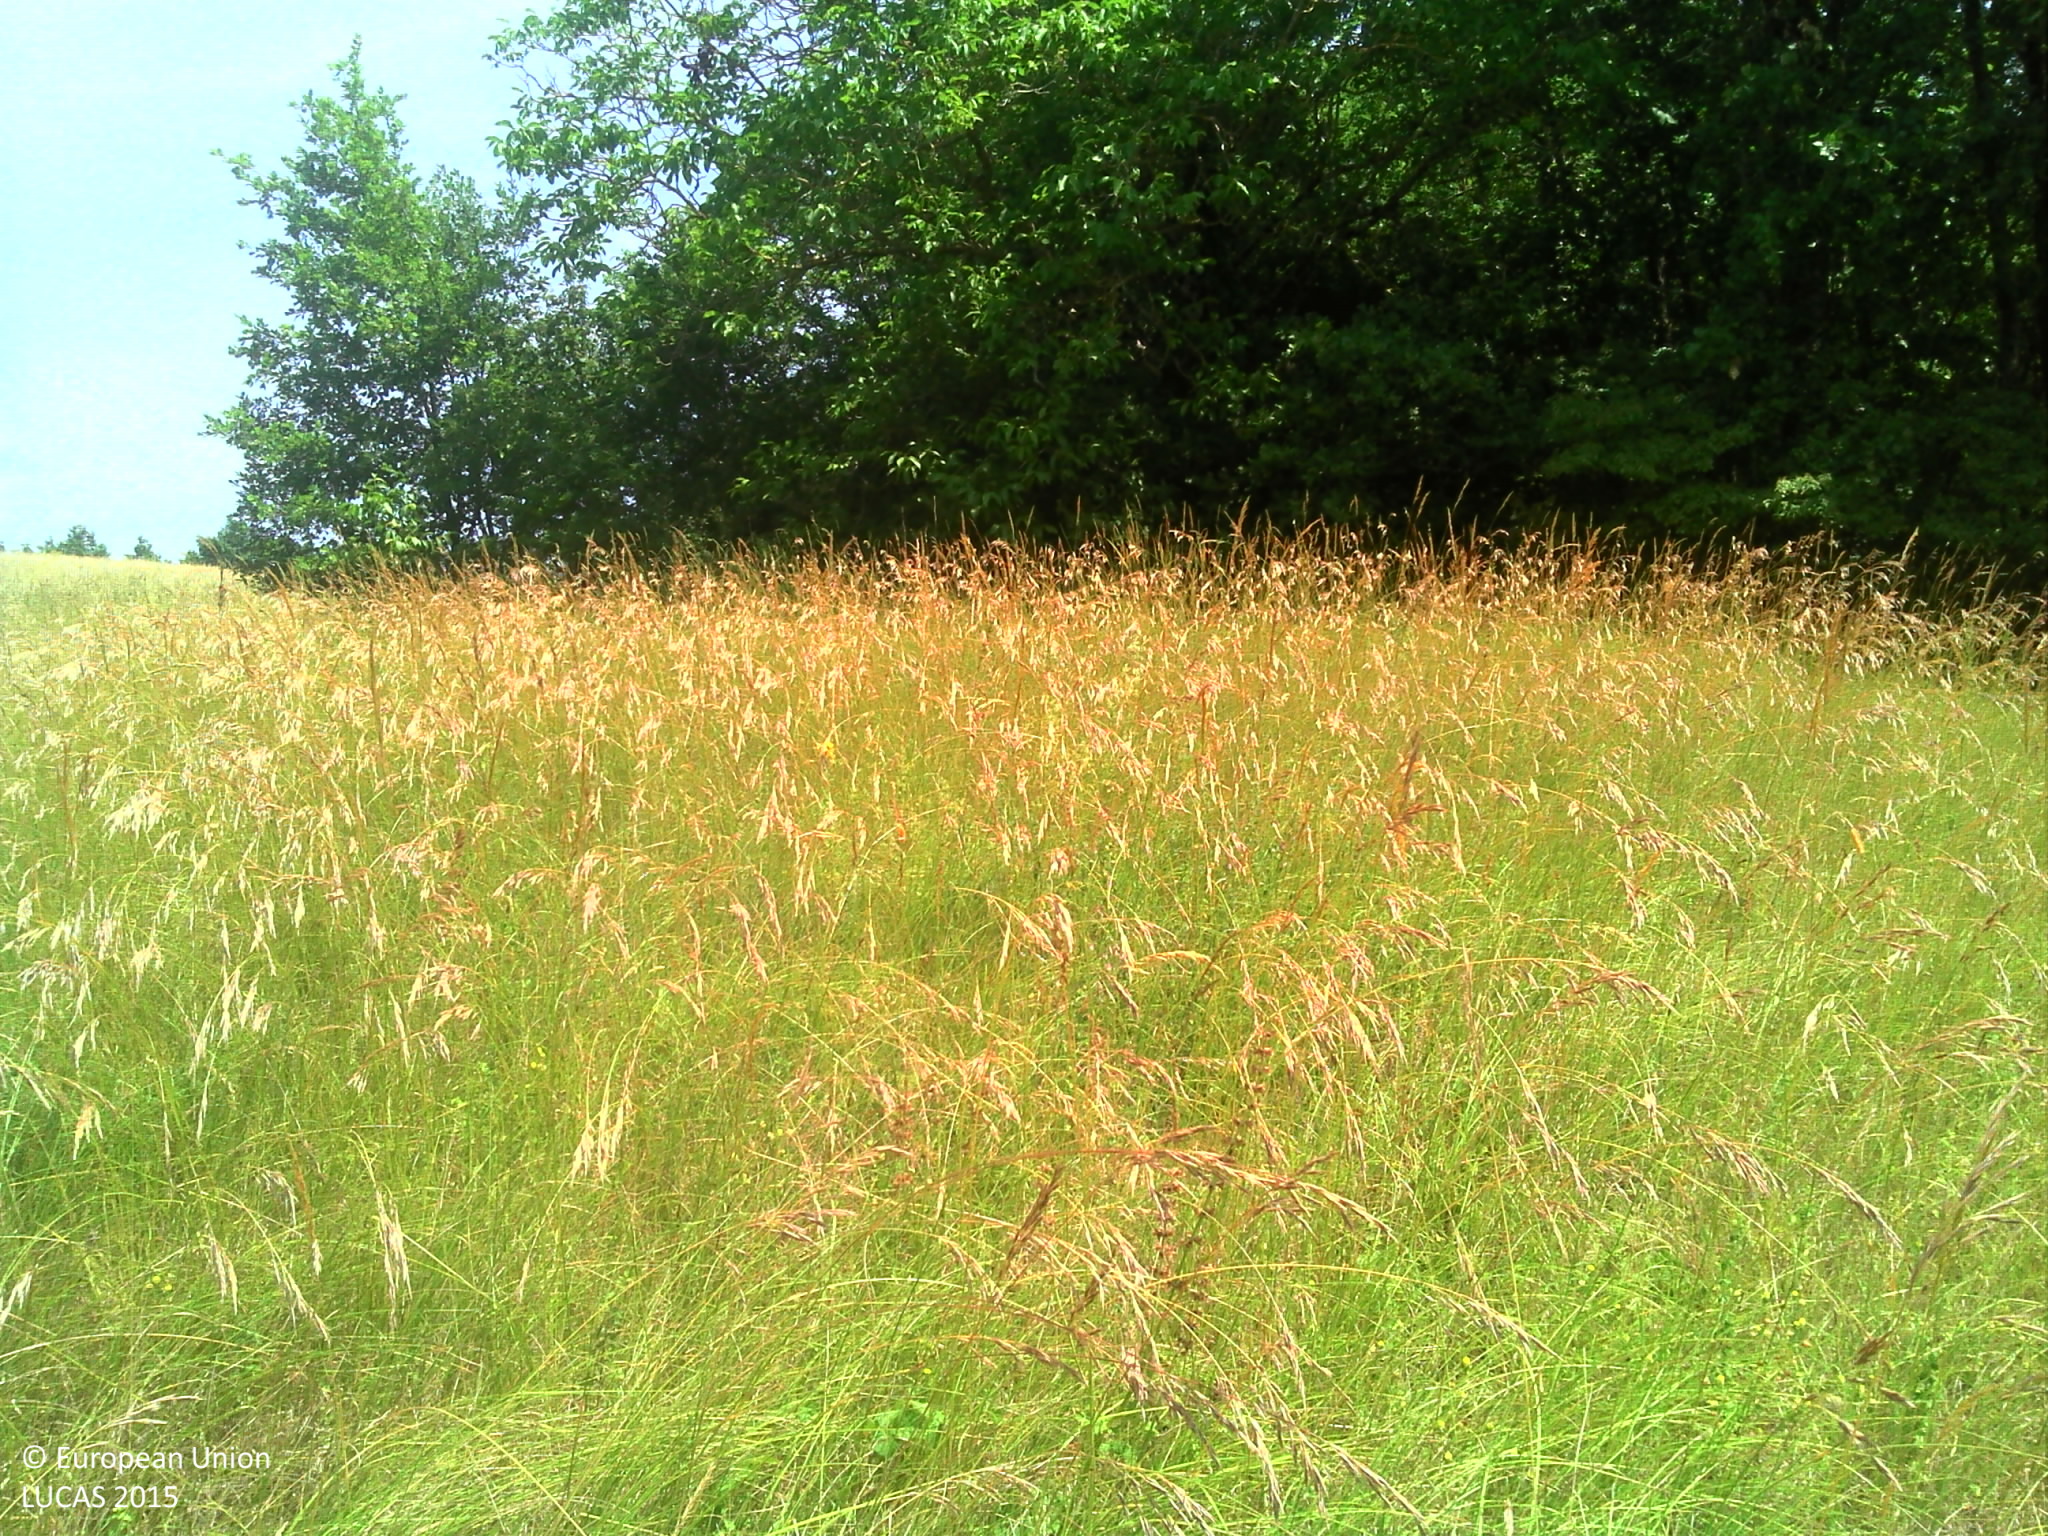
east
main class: Grassland
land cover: Grassland without tree/shrub cover
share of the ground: > 75 %
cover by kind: herbaceous plants 100 %
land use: Agriculture (excluding fallow land and kitchen gardens)
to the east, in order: Grassland without tree/shrub cover; Broadleaved woodland; Grassland without tree/shrub cover; Broadleaved woodland; Grassland without tree/shrub cover; Shrubland with sparse tree cover; Paved roads, cycling and walking lanes; Grass margins; Fences; Managed hedges; Grassland with sparse tree/shrub cover; Lines of trees; Grassland with sparse tree/shrub cover; Fences; Grassland with sparse tree/shrub cover
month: June
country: FR
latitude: 43.9543
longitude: 1.5900
